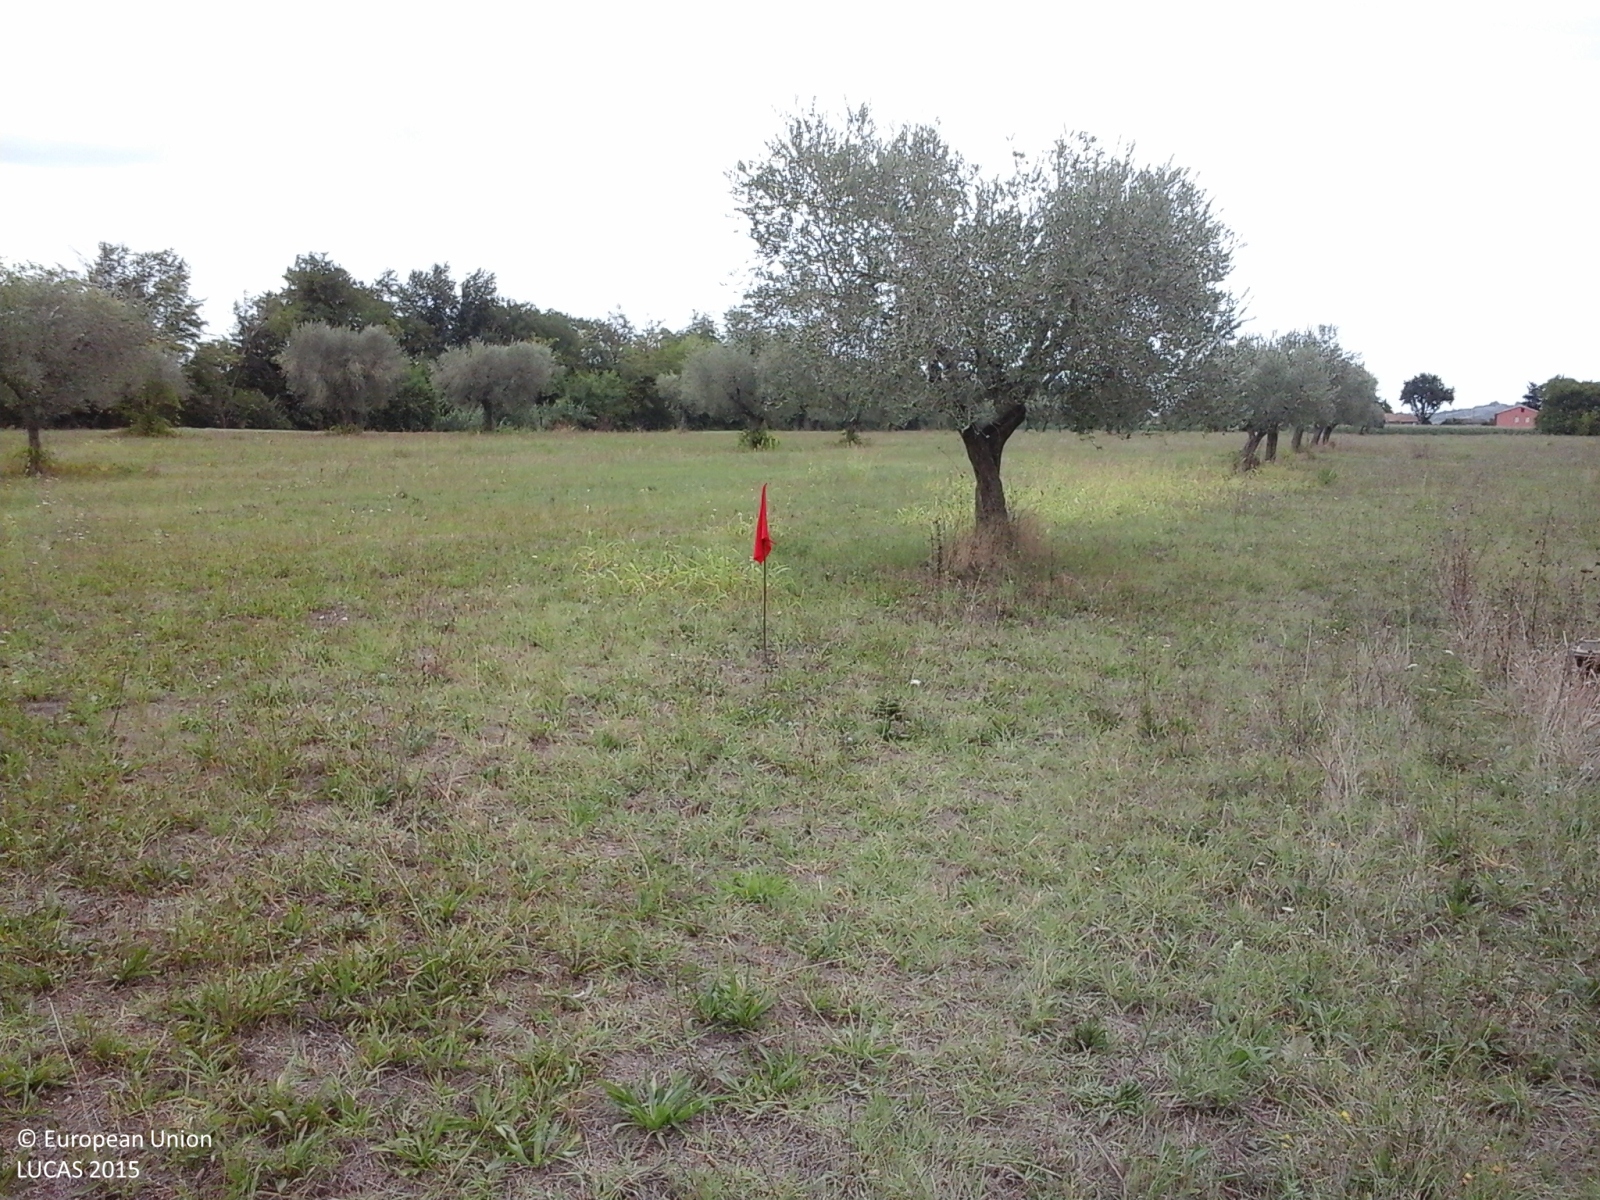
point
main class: Cropland
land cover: Olive groves
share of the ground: < 10 %
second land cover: Spontaneously vegetated surfaces
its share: > 75 %
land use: Agriculture (excluding fallow land and kitchen gardens)
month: September
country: IT
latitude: 42.7991
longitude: 13.8163
